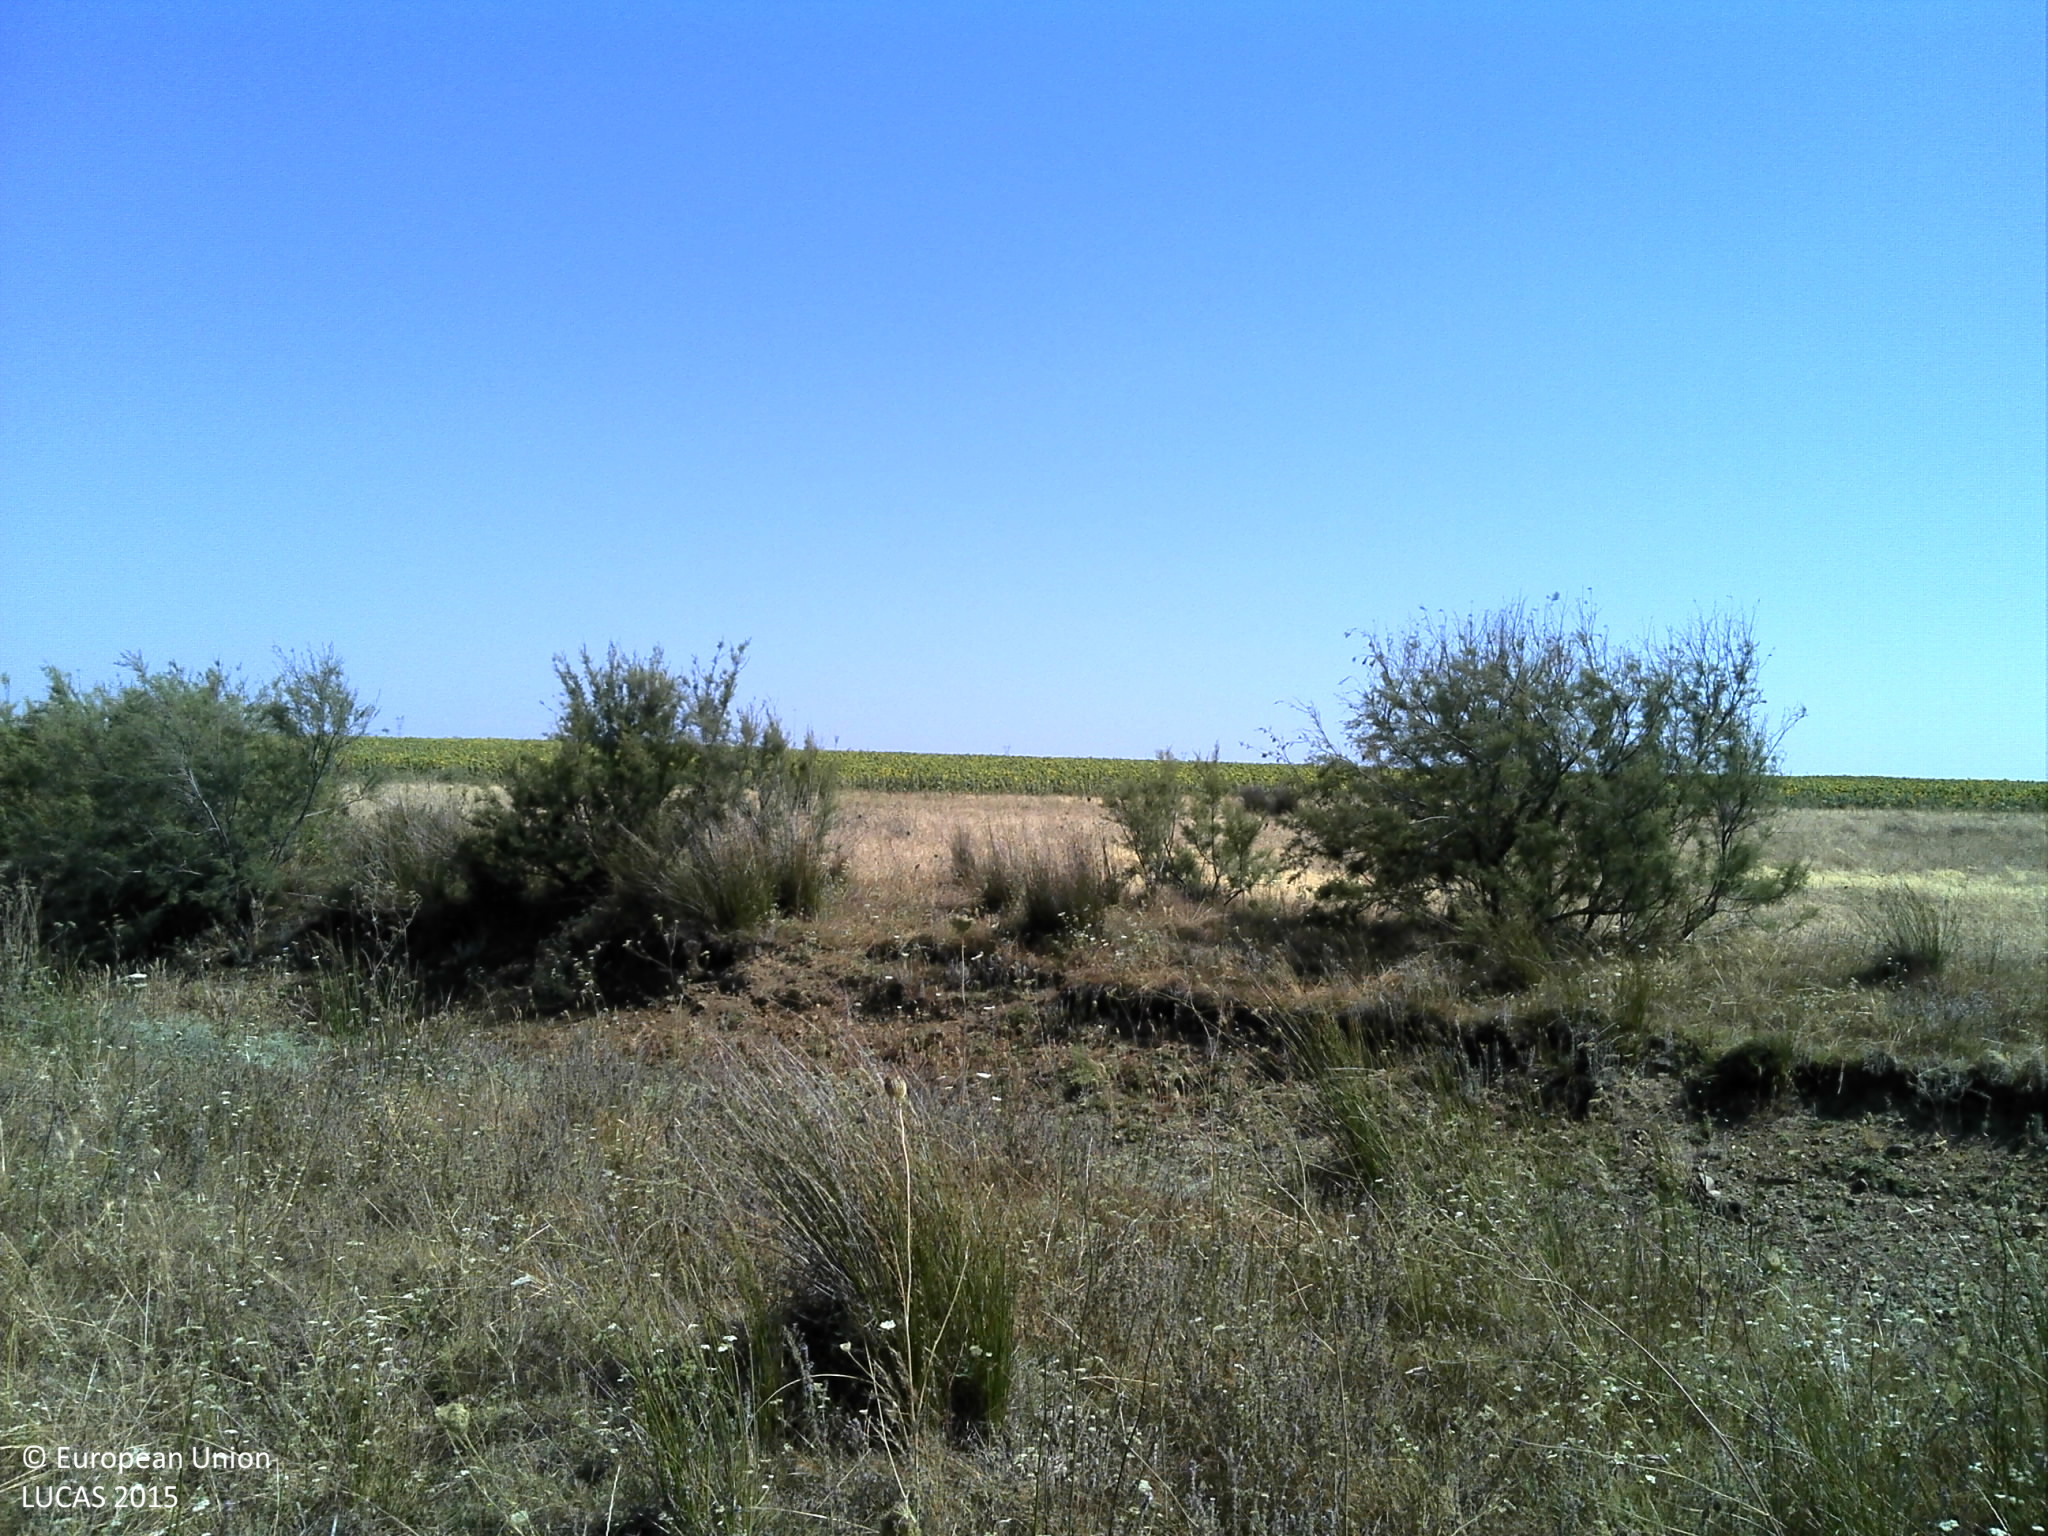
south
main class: Grassland
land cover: Grassland without tree/shrub cover
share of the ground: 50 - 75 %
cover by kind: herbaceous plants 50 %, unconsolidated bare surface 50 %
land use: Agriculture (excluding fallow land and kitchen gardens)
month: June
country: PT
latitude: 38.1690
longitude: -8.0585
